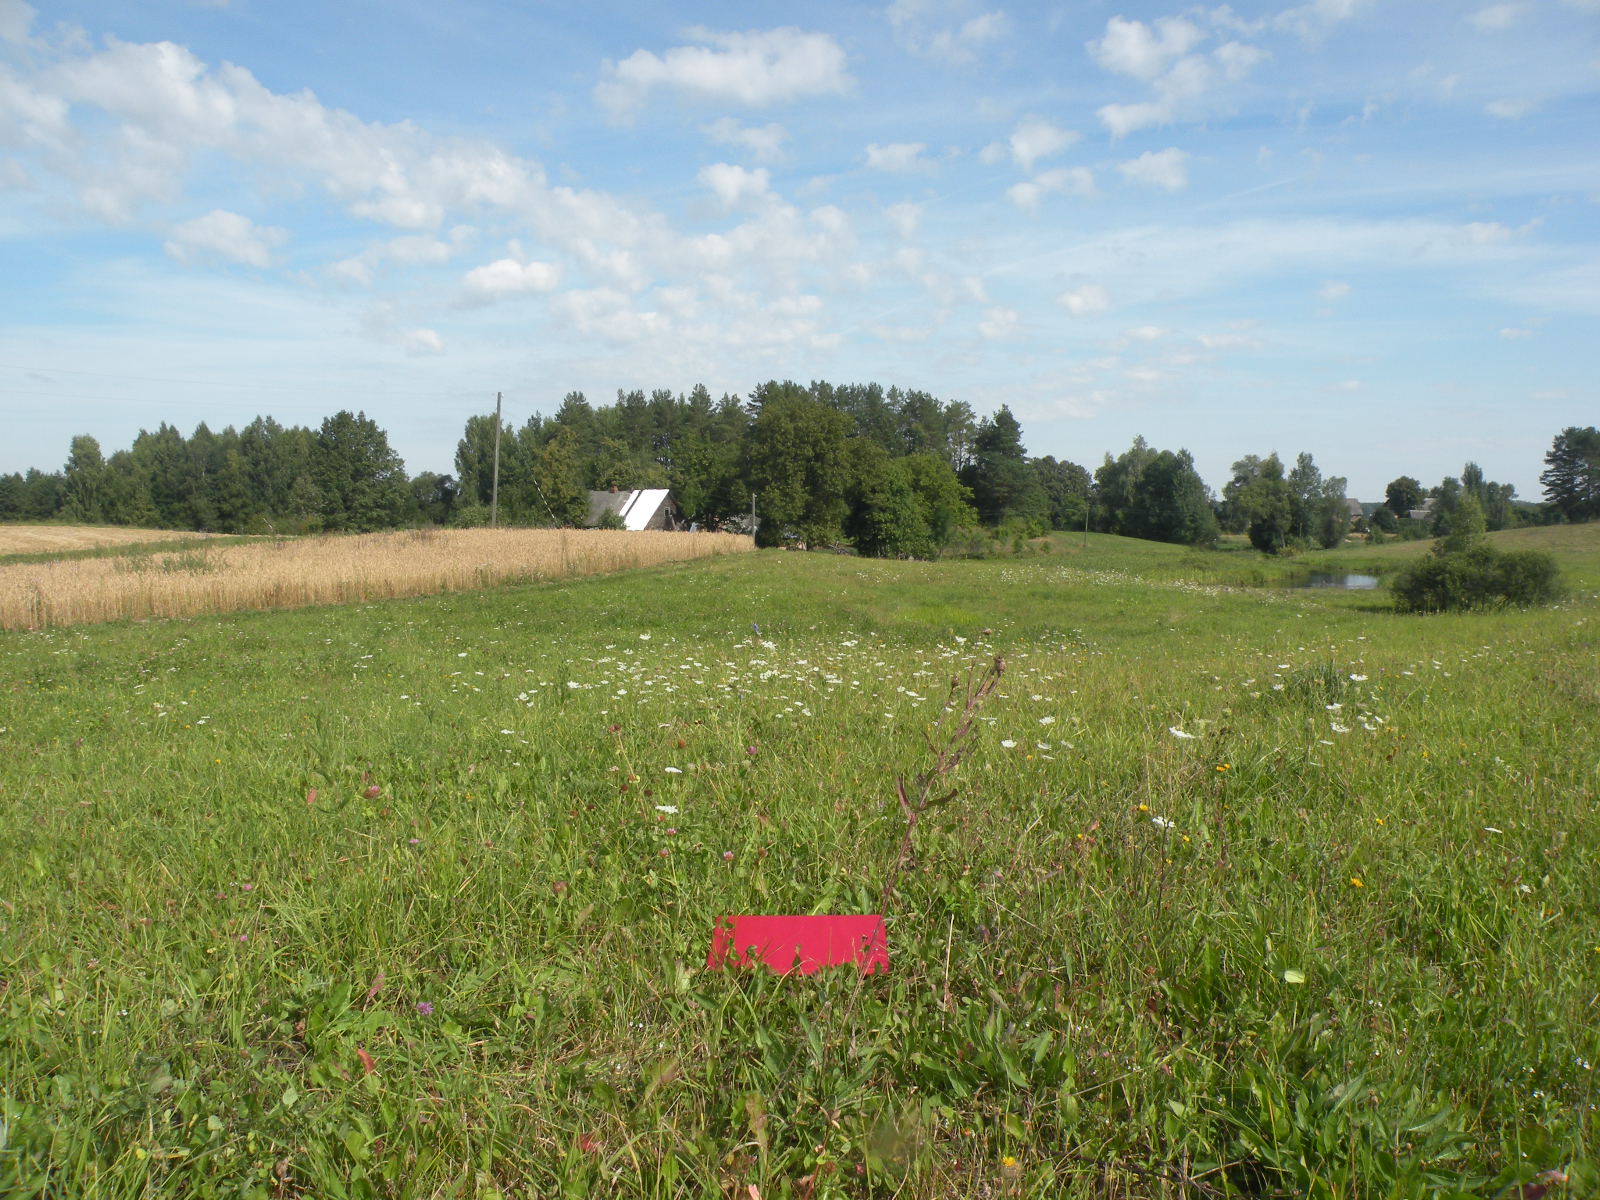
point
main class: Grassland
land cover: Grassland without tree/shrub cover
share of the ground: > 75 %
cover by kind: herbaceous plants 100 %
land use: Agriculture (excluding fallow land and kitchen gardens)
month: August
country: LV
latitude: 55.9132
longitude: 26.2542
